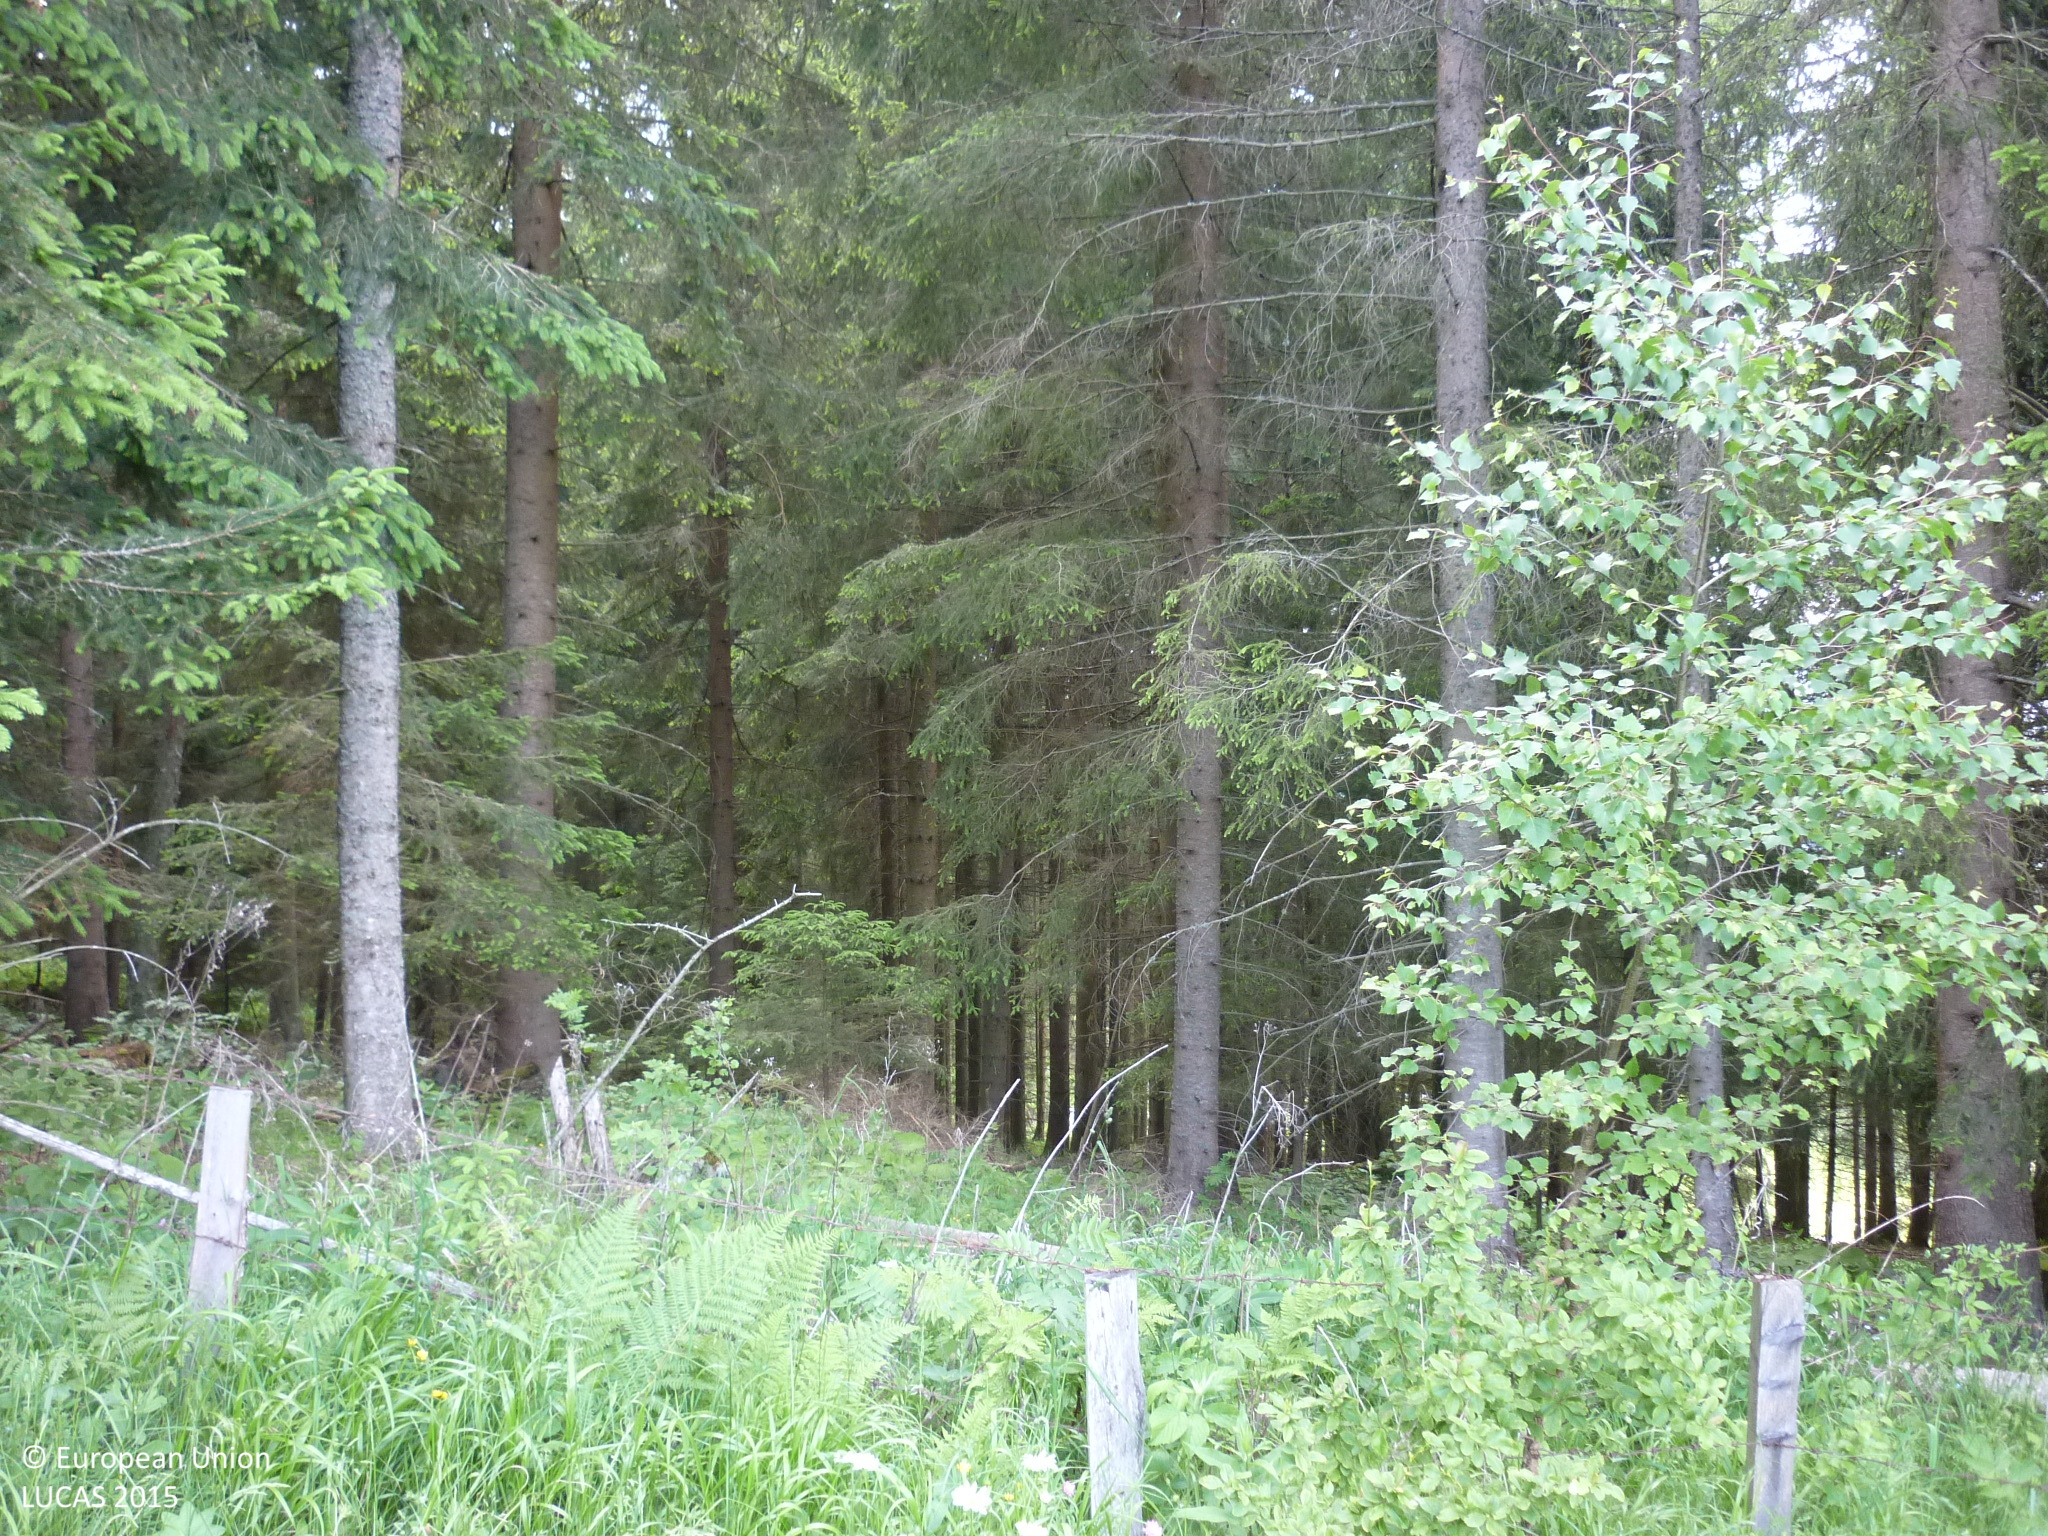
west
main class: Grassland
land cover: Grassland without tree/shrub cover
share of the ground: > 75 %
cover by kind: herbaceous plants 100 %
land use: Agriculture (excluding fallow land and kitchen gardens)
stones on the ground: < 10 %
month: June
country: AT
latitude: 47.2198
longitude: 14.3166
